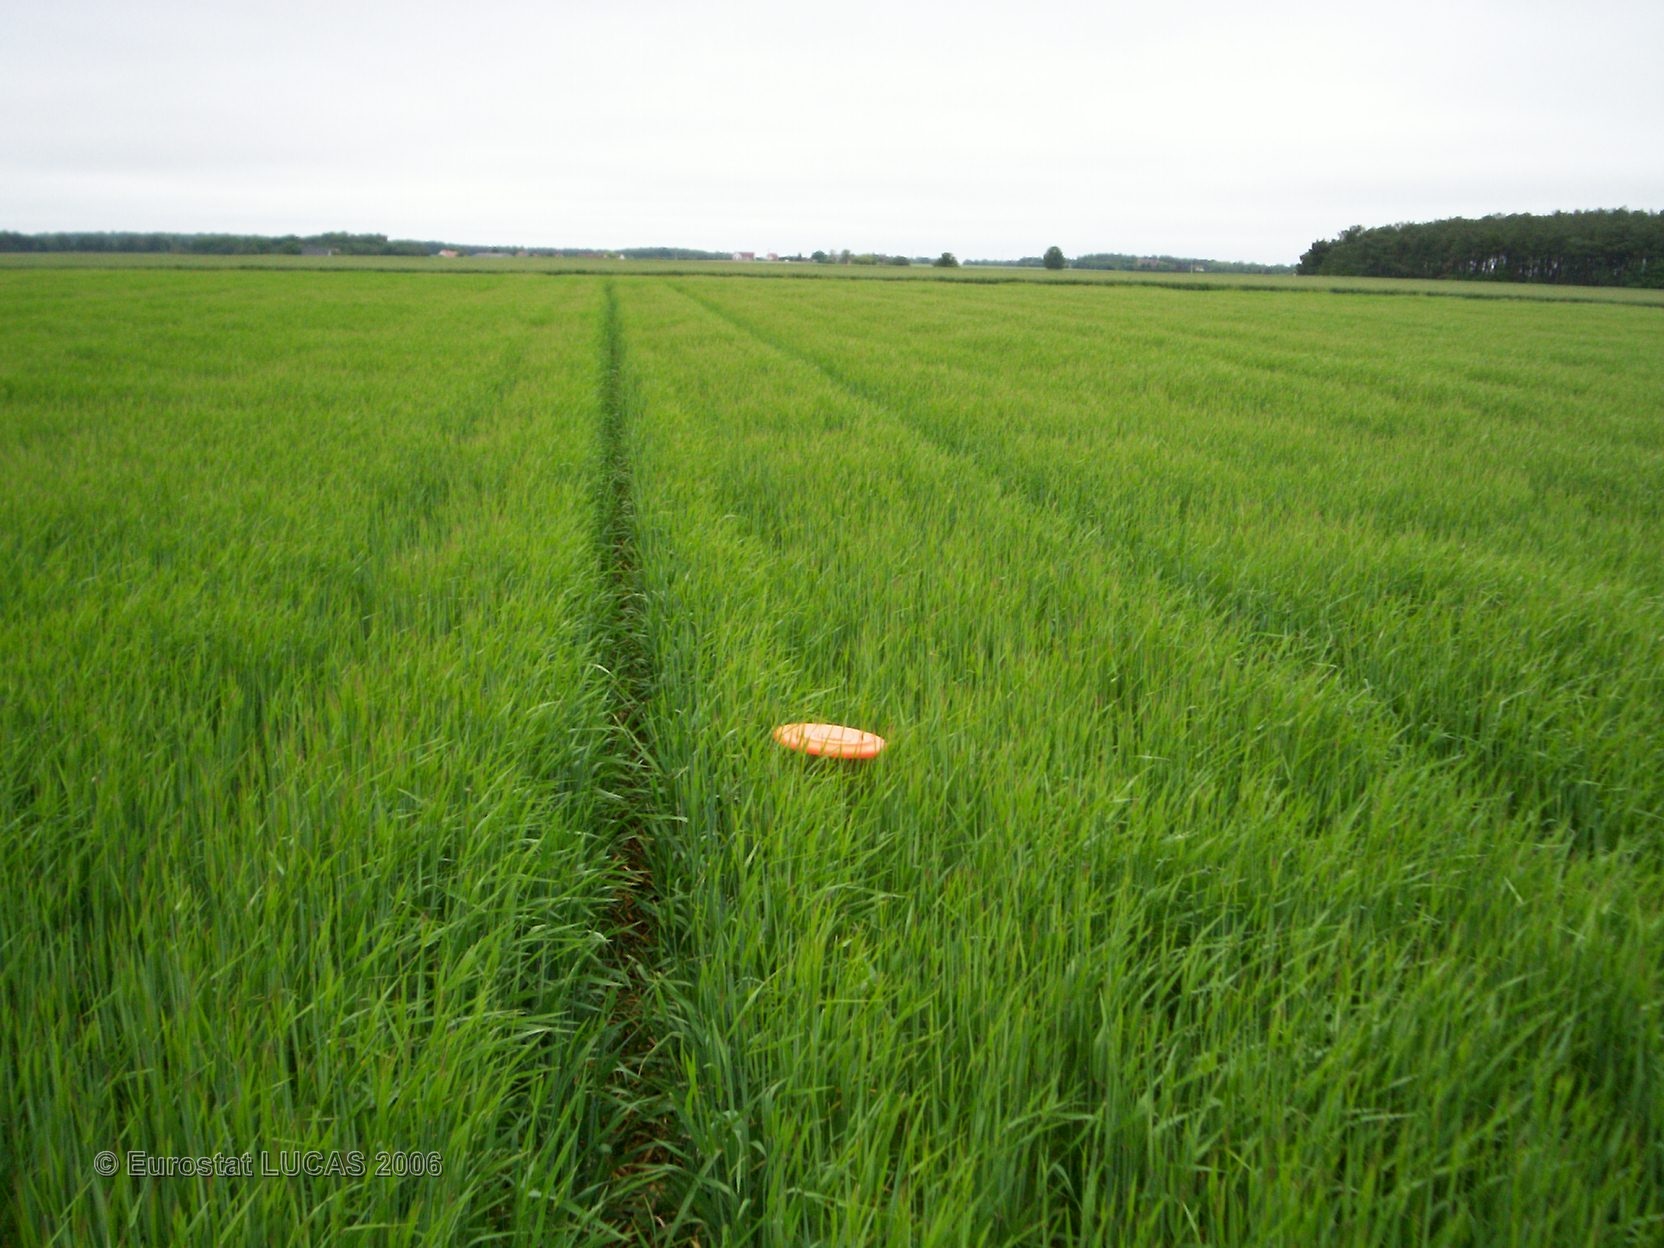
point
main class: Cropland
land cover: Triticale
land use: Agriculture (excluding fallow land and kitchen gardens)
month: May
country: FR
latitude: 47.3029
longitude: 0.8963
